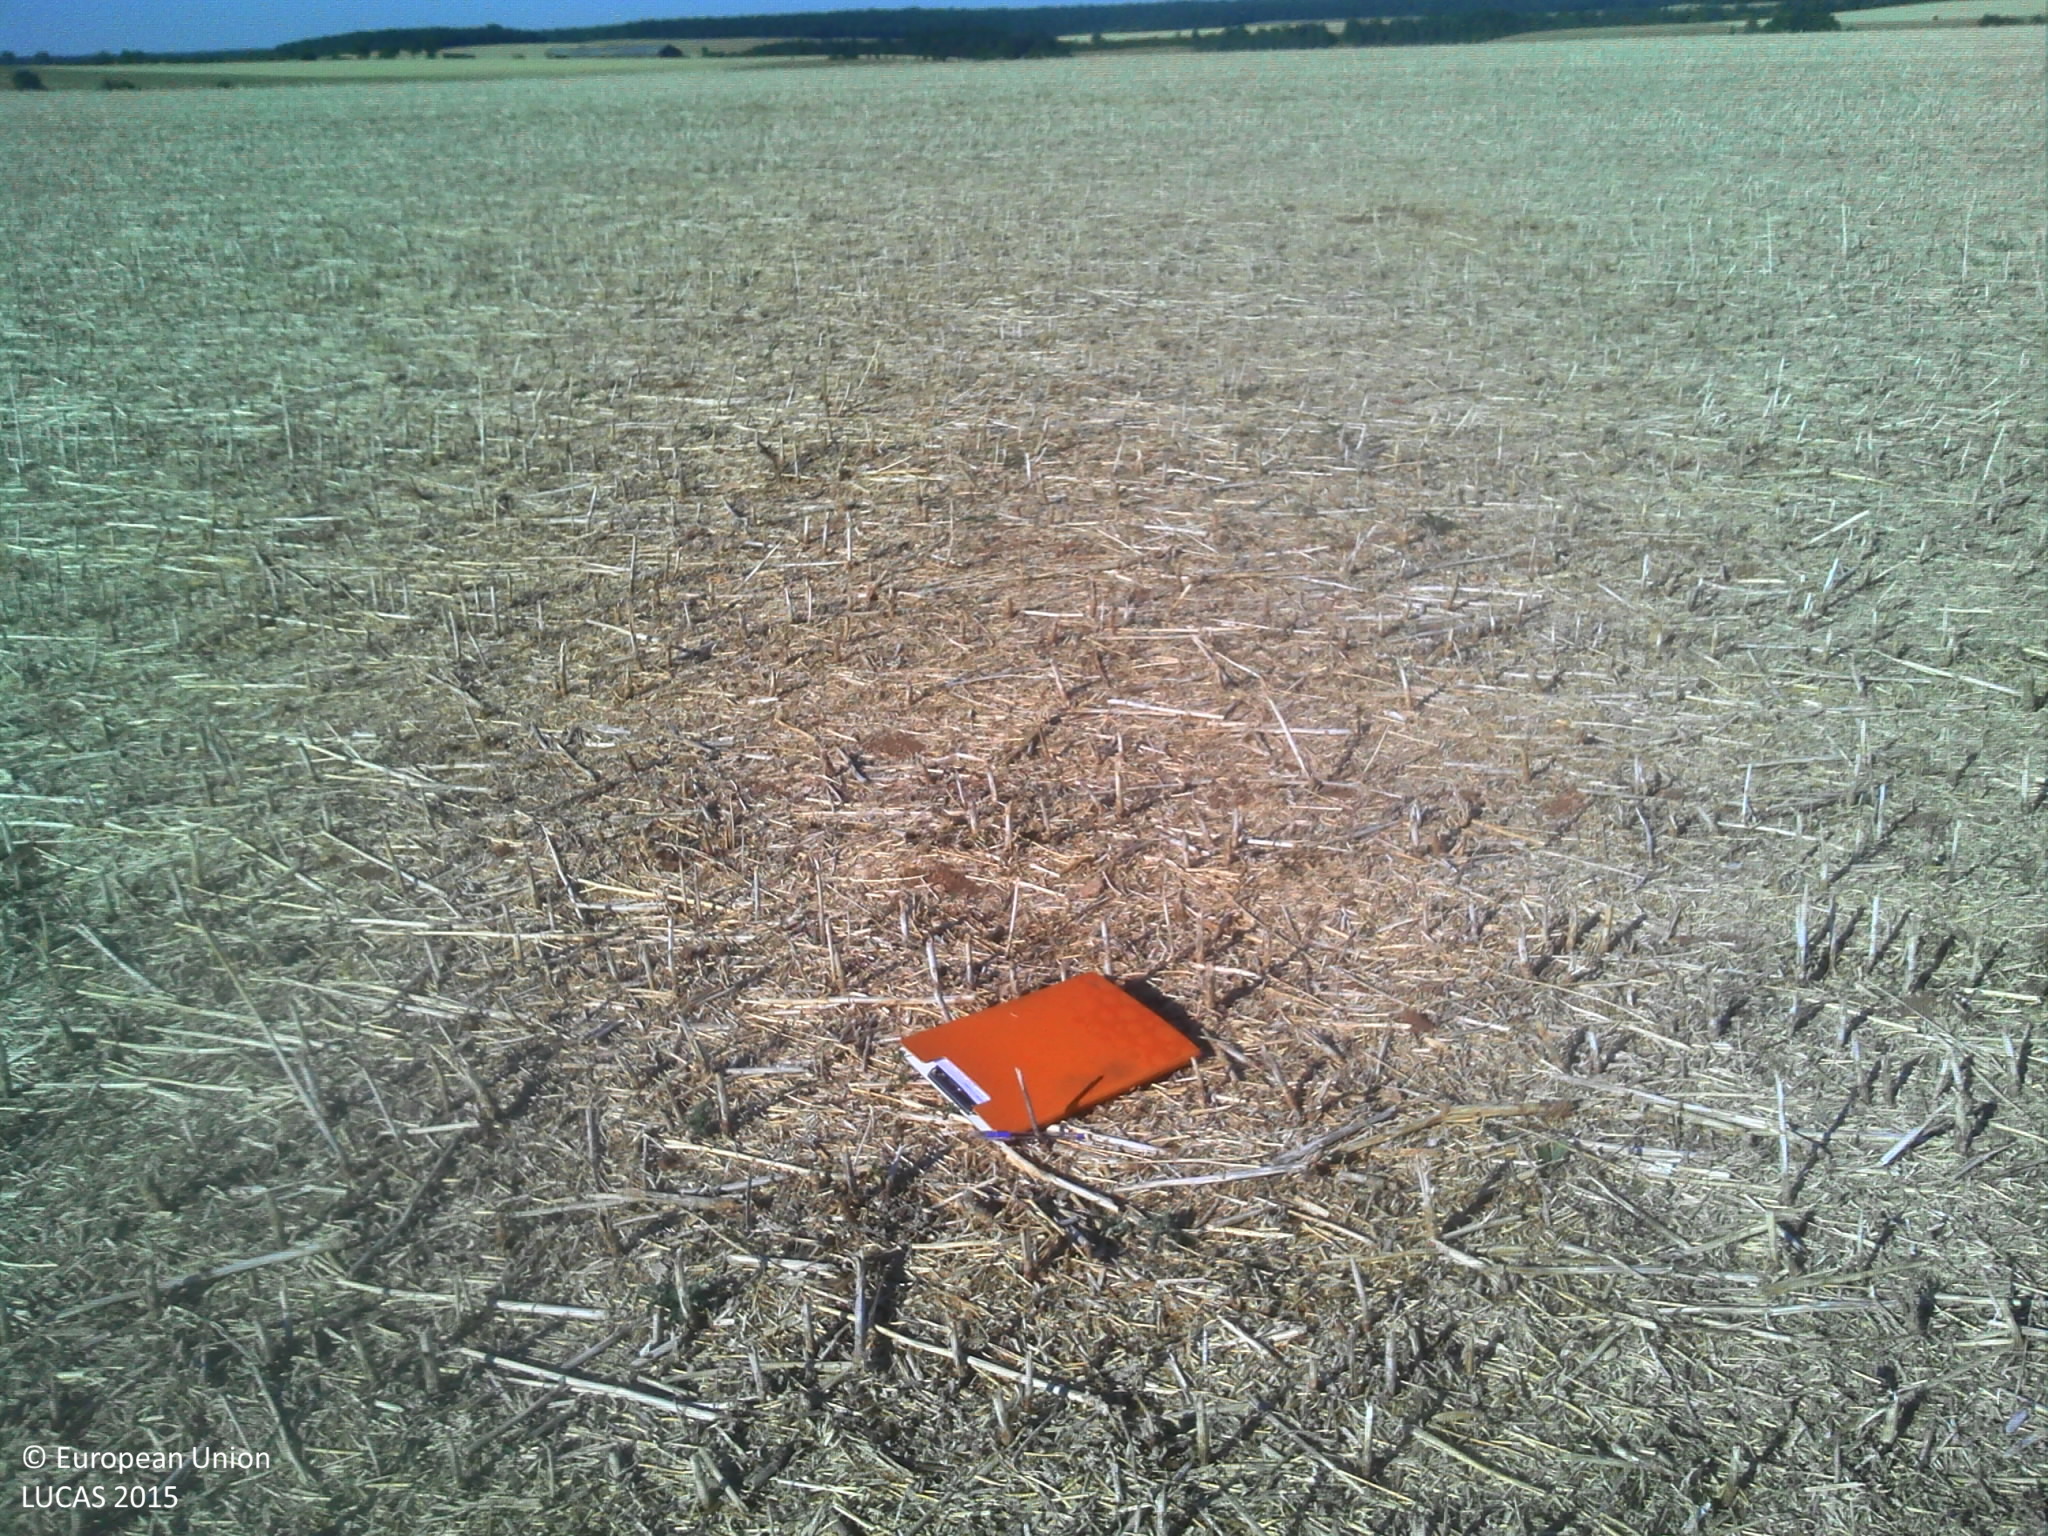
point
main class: Cropland
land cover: Rape and turnip rape
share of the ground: 10 - 25 %
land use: Agriculture (excluding fallow land and kitchen gardens)
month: August
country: FR
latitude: 47.6944
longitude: 4.9764
